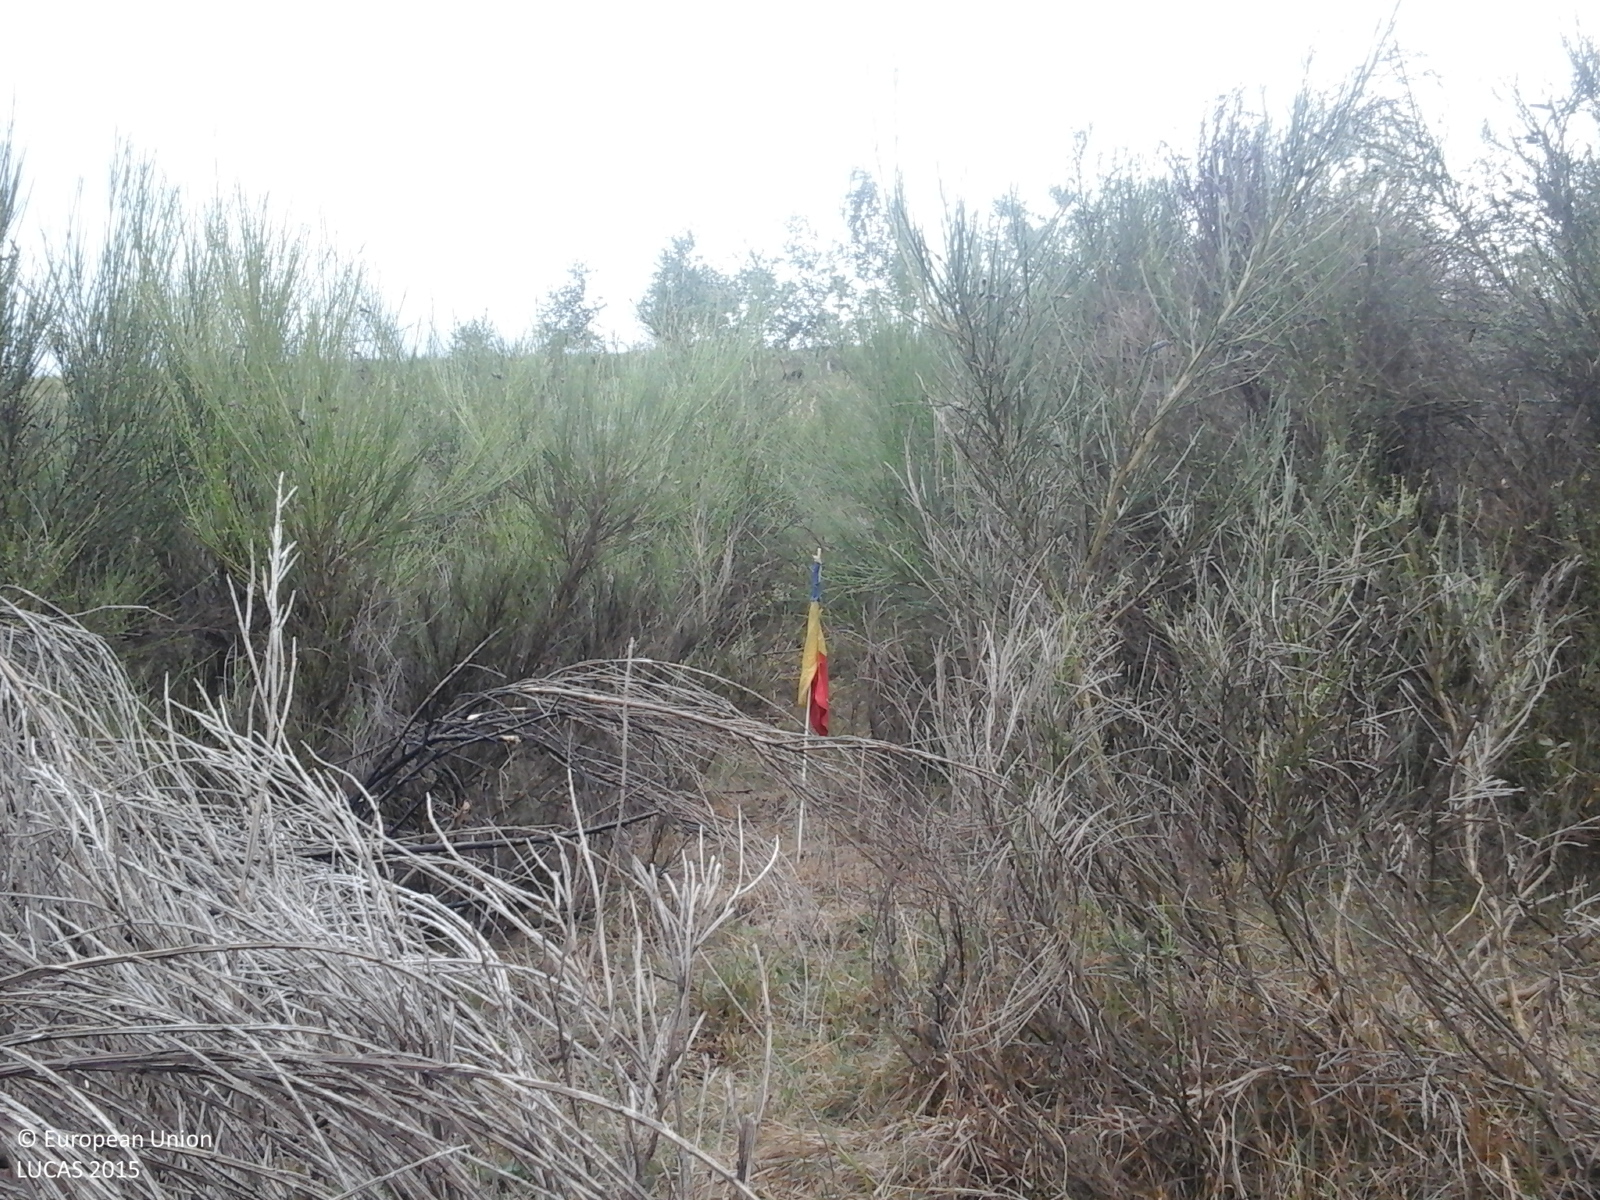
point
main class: Shrubland
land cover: Shrubland with sparse tree cover
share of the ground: > 75 %
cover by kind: herbaceous plants 70 %, shrubs 25 %, broadleaved forest trees 5 %
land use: Semi-natural and natural areas not in use
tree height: < 5 m
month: September
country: RO
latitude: 47.8072
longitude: 23.3593
